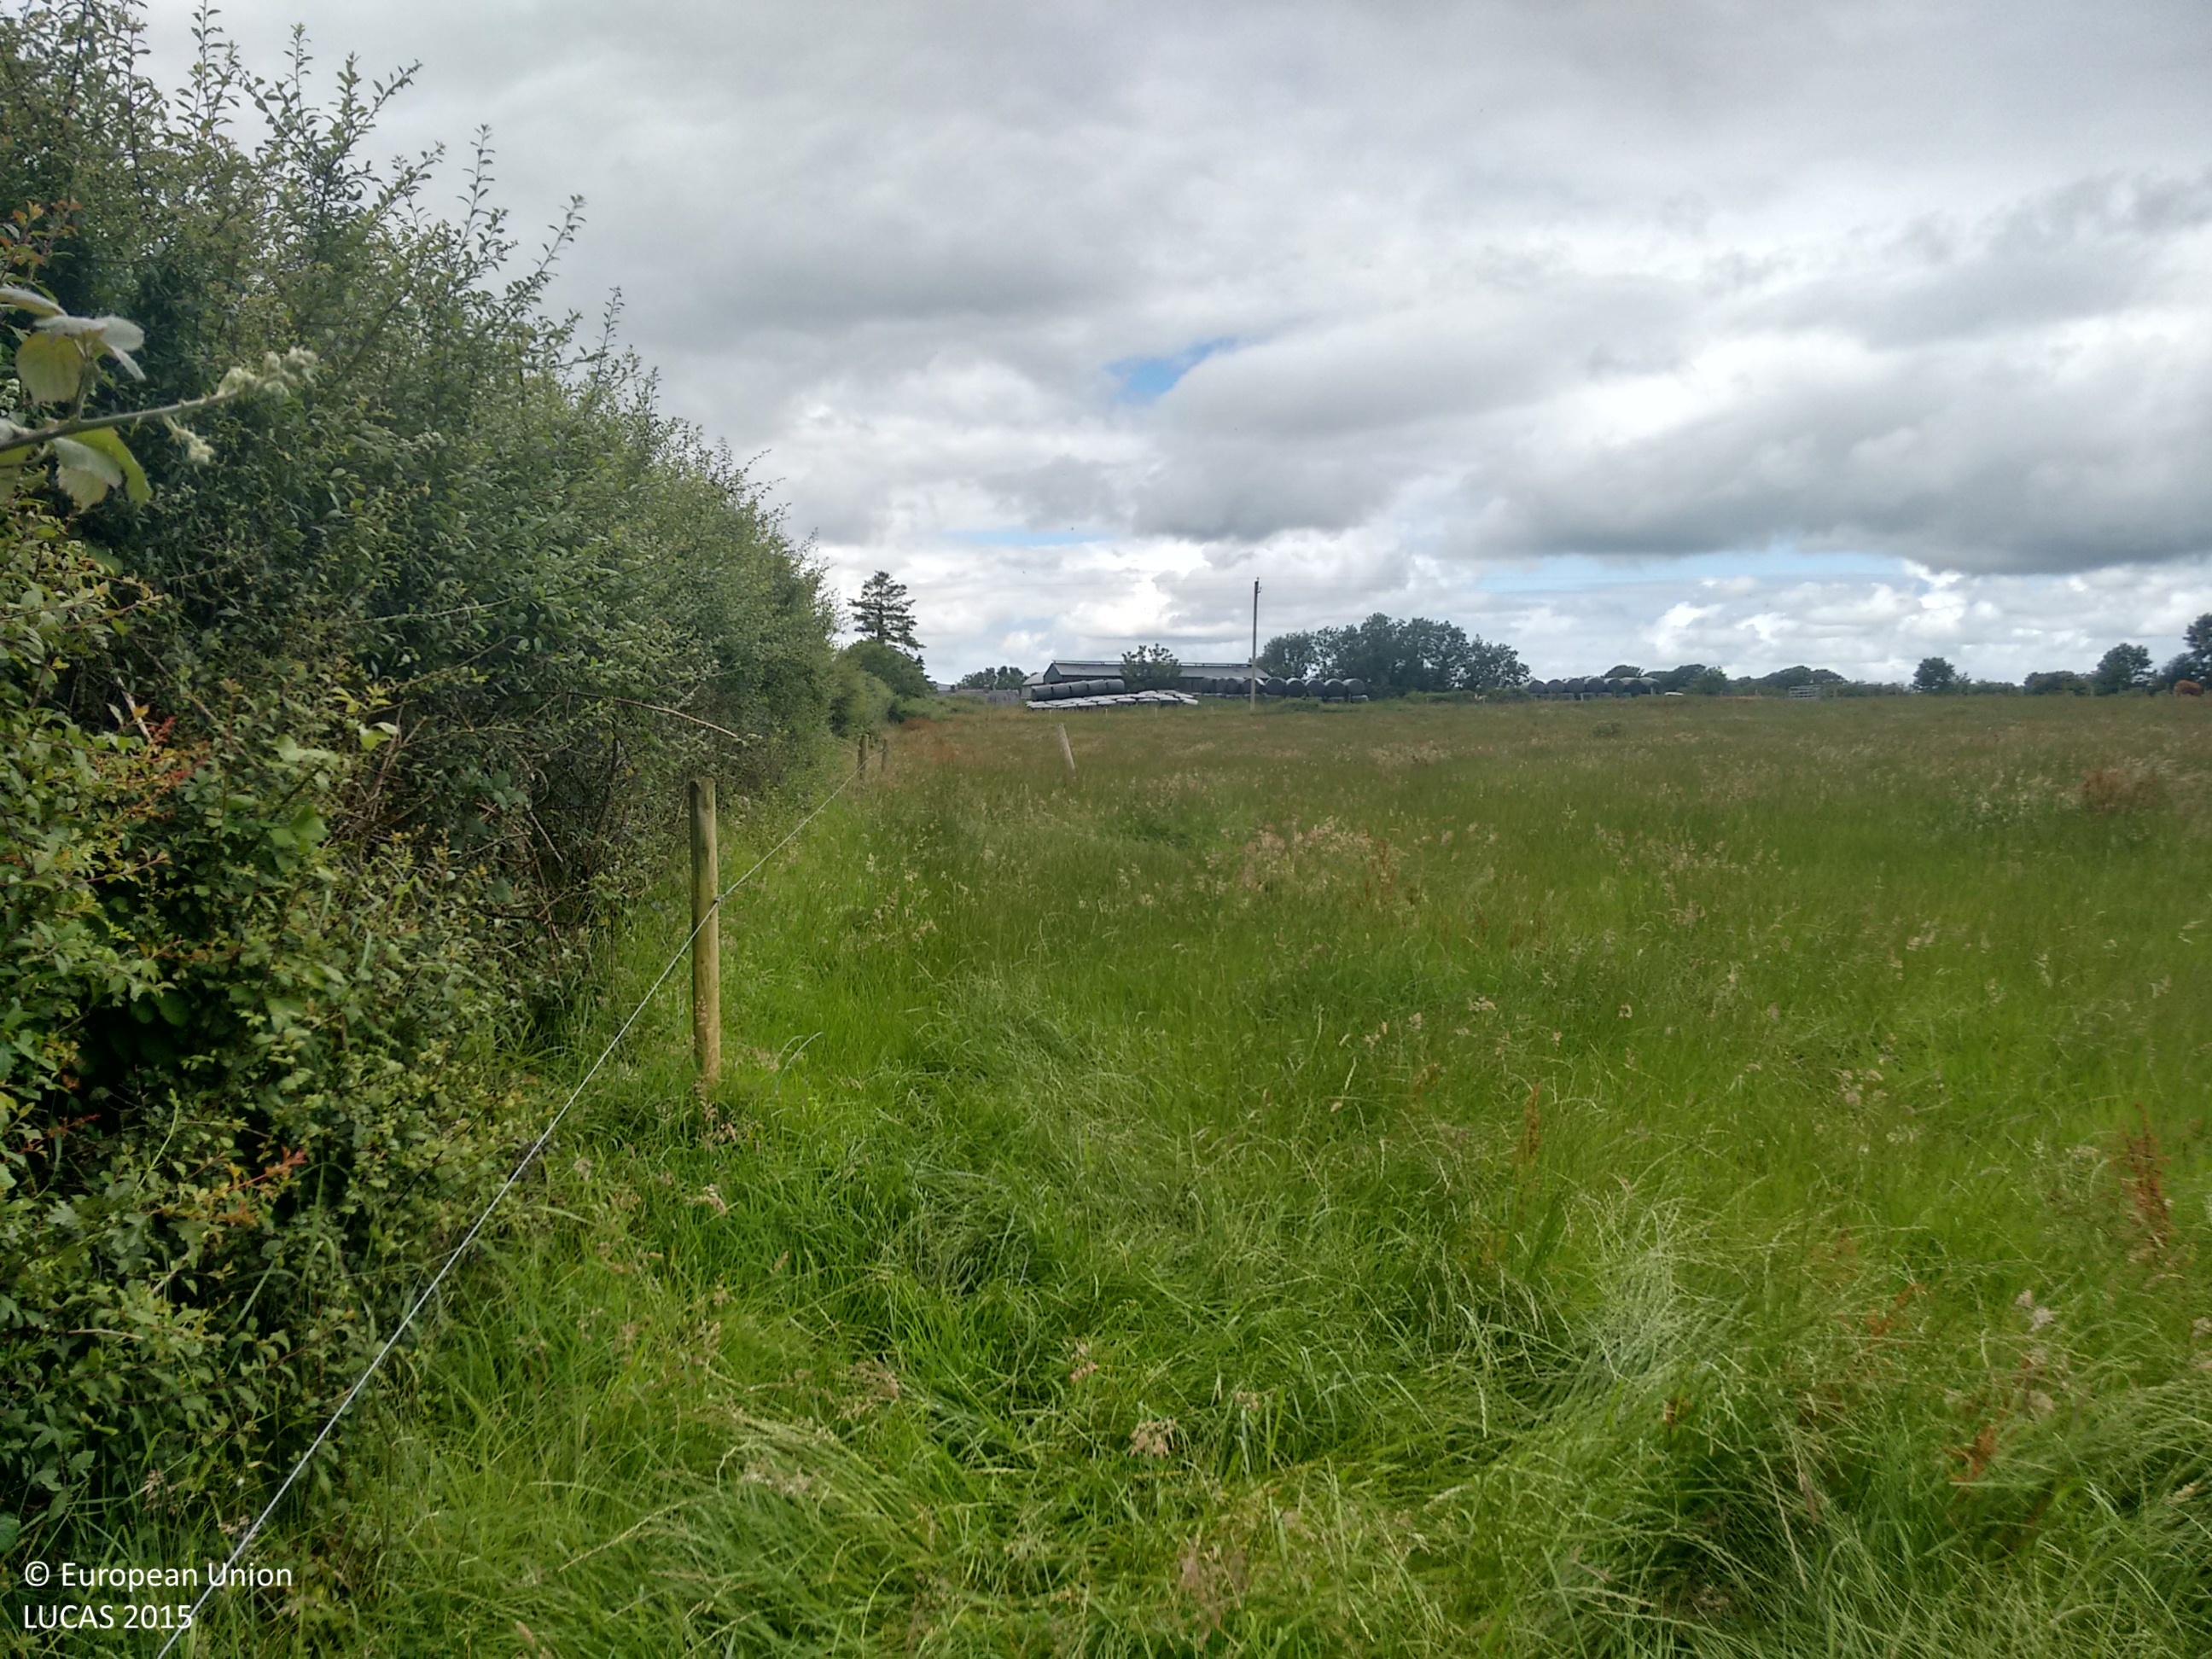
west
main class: Grassland
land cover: Grassland without tree/shrub cover
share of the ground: > 75 %
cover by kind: herbaceous plants 100 %
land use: Agriculture (excluding fallow land and kitchen gardens)
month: July
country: IE
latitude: 53.7181
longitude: -9.1759
